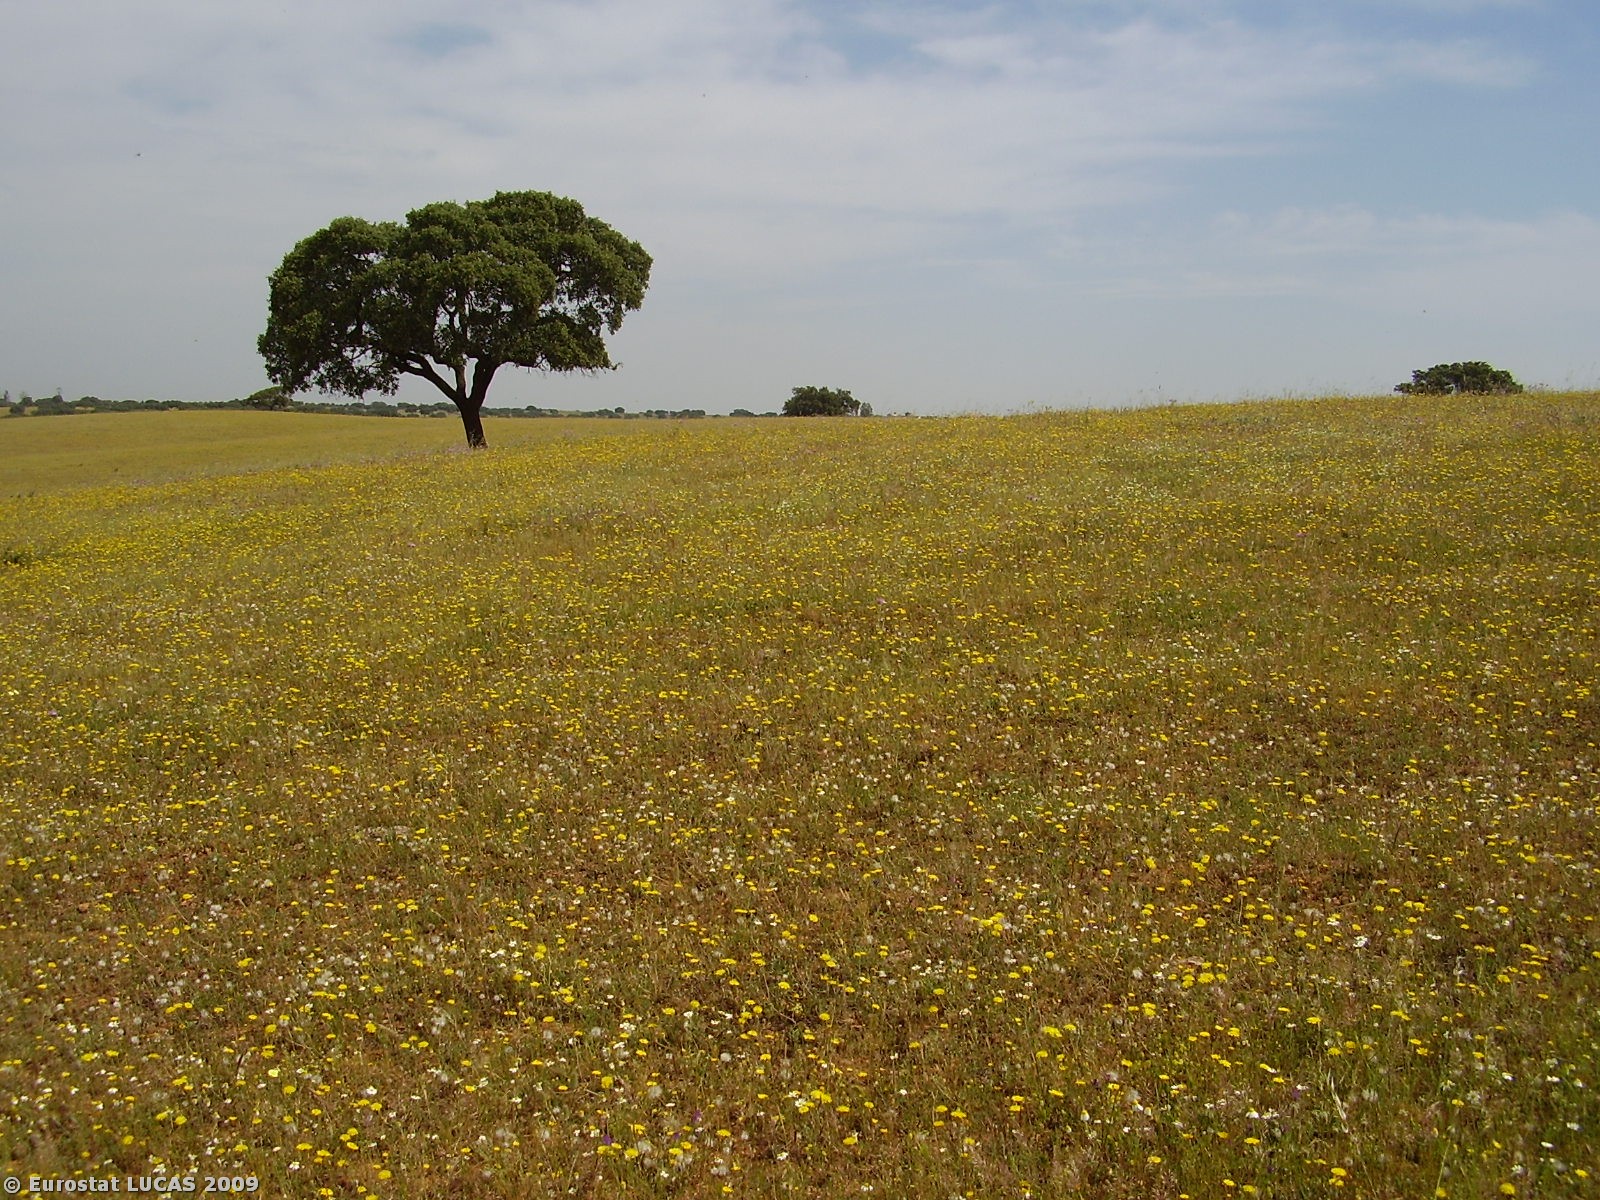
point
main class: Grassland
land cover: Grassland with sparse tree/shrub cover
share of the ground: > 75 %
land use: Agriculture (excluding fallow land and kitchen gardens)
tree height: > 5 m
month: May
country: PT
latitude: 37.9179
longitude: -7.9204
